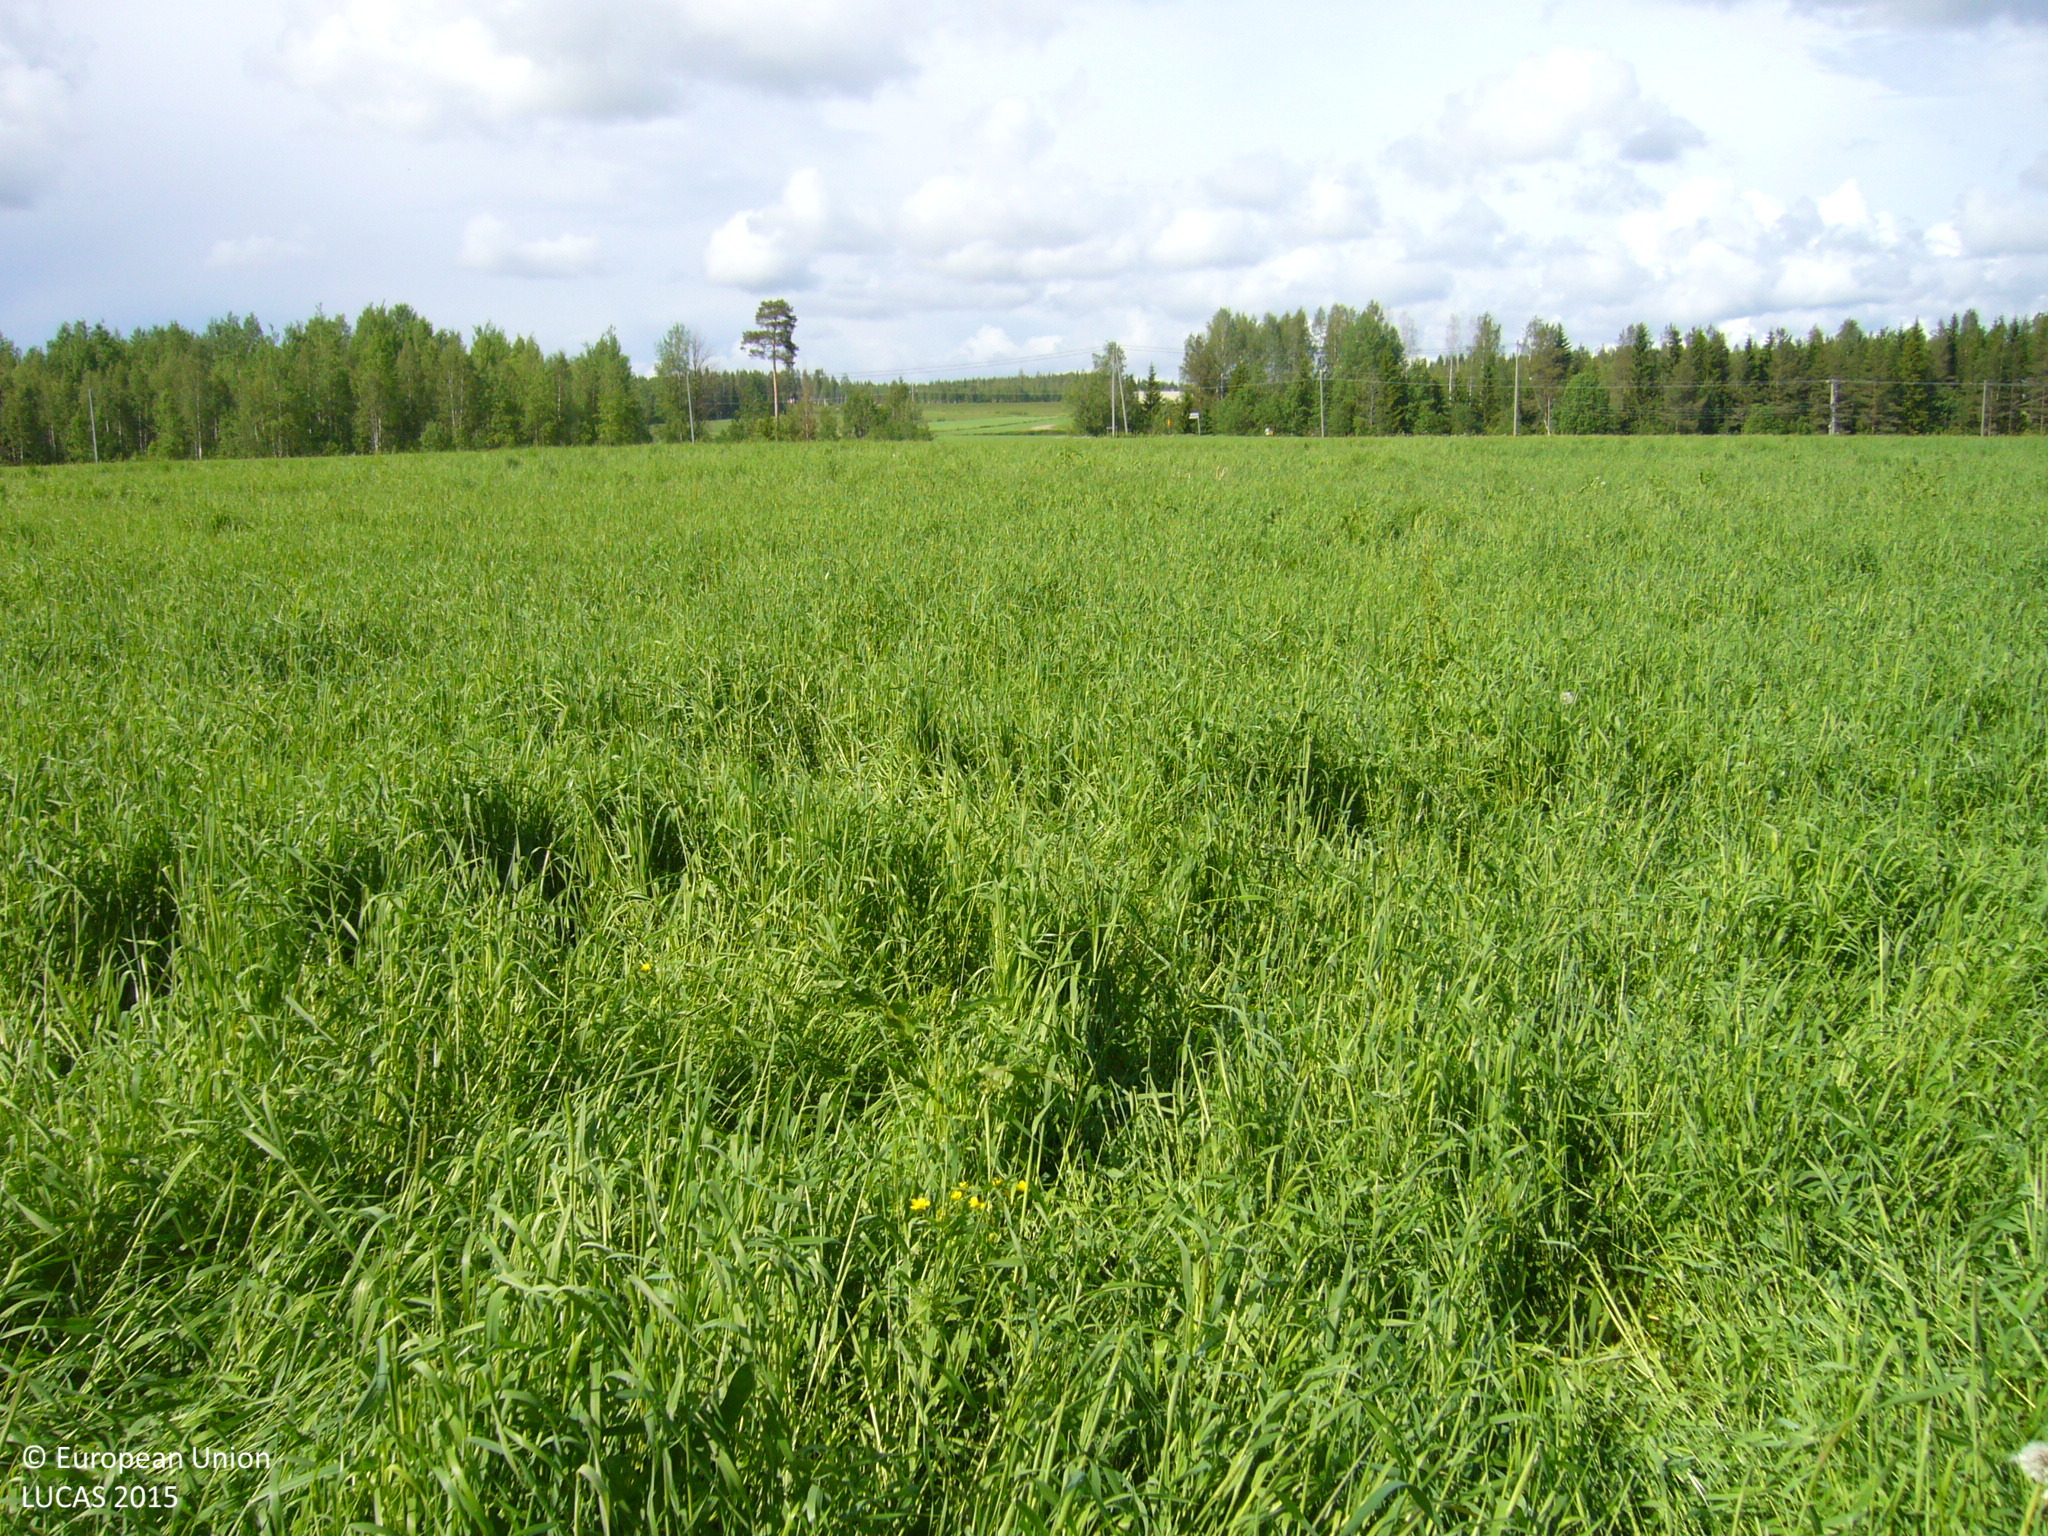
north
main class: Cropland
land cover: Temporary grasslands
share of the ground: > 75 %
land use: Agriculture (excluding fallow land and kitchen gardens)
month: June
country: FI
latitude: 63.7842
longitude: 26.3302
